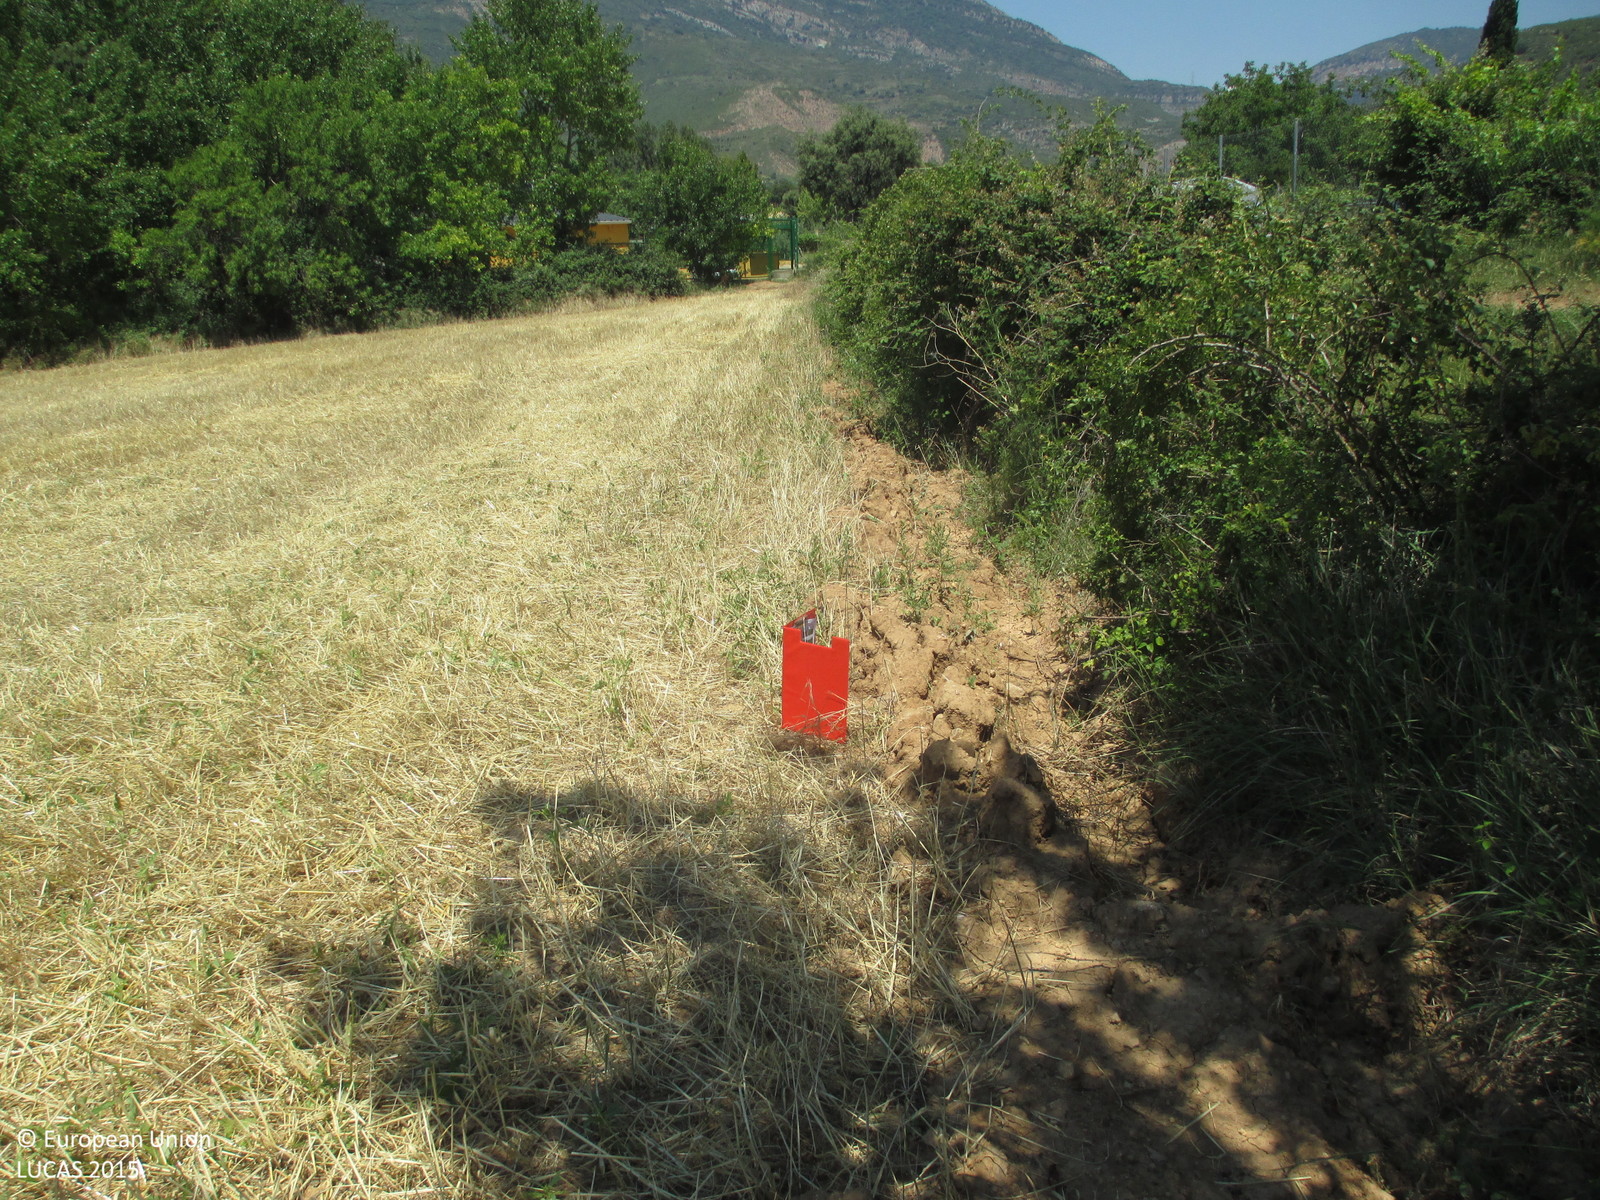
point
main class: Cropland
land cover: Barley
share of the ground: < 10 %
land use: Agriculture (excluding fallow land and kitchen gardens)
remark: Harvested field
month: June
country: ES
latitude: 42.2590
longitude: -0.4366
